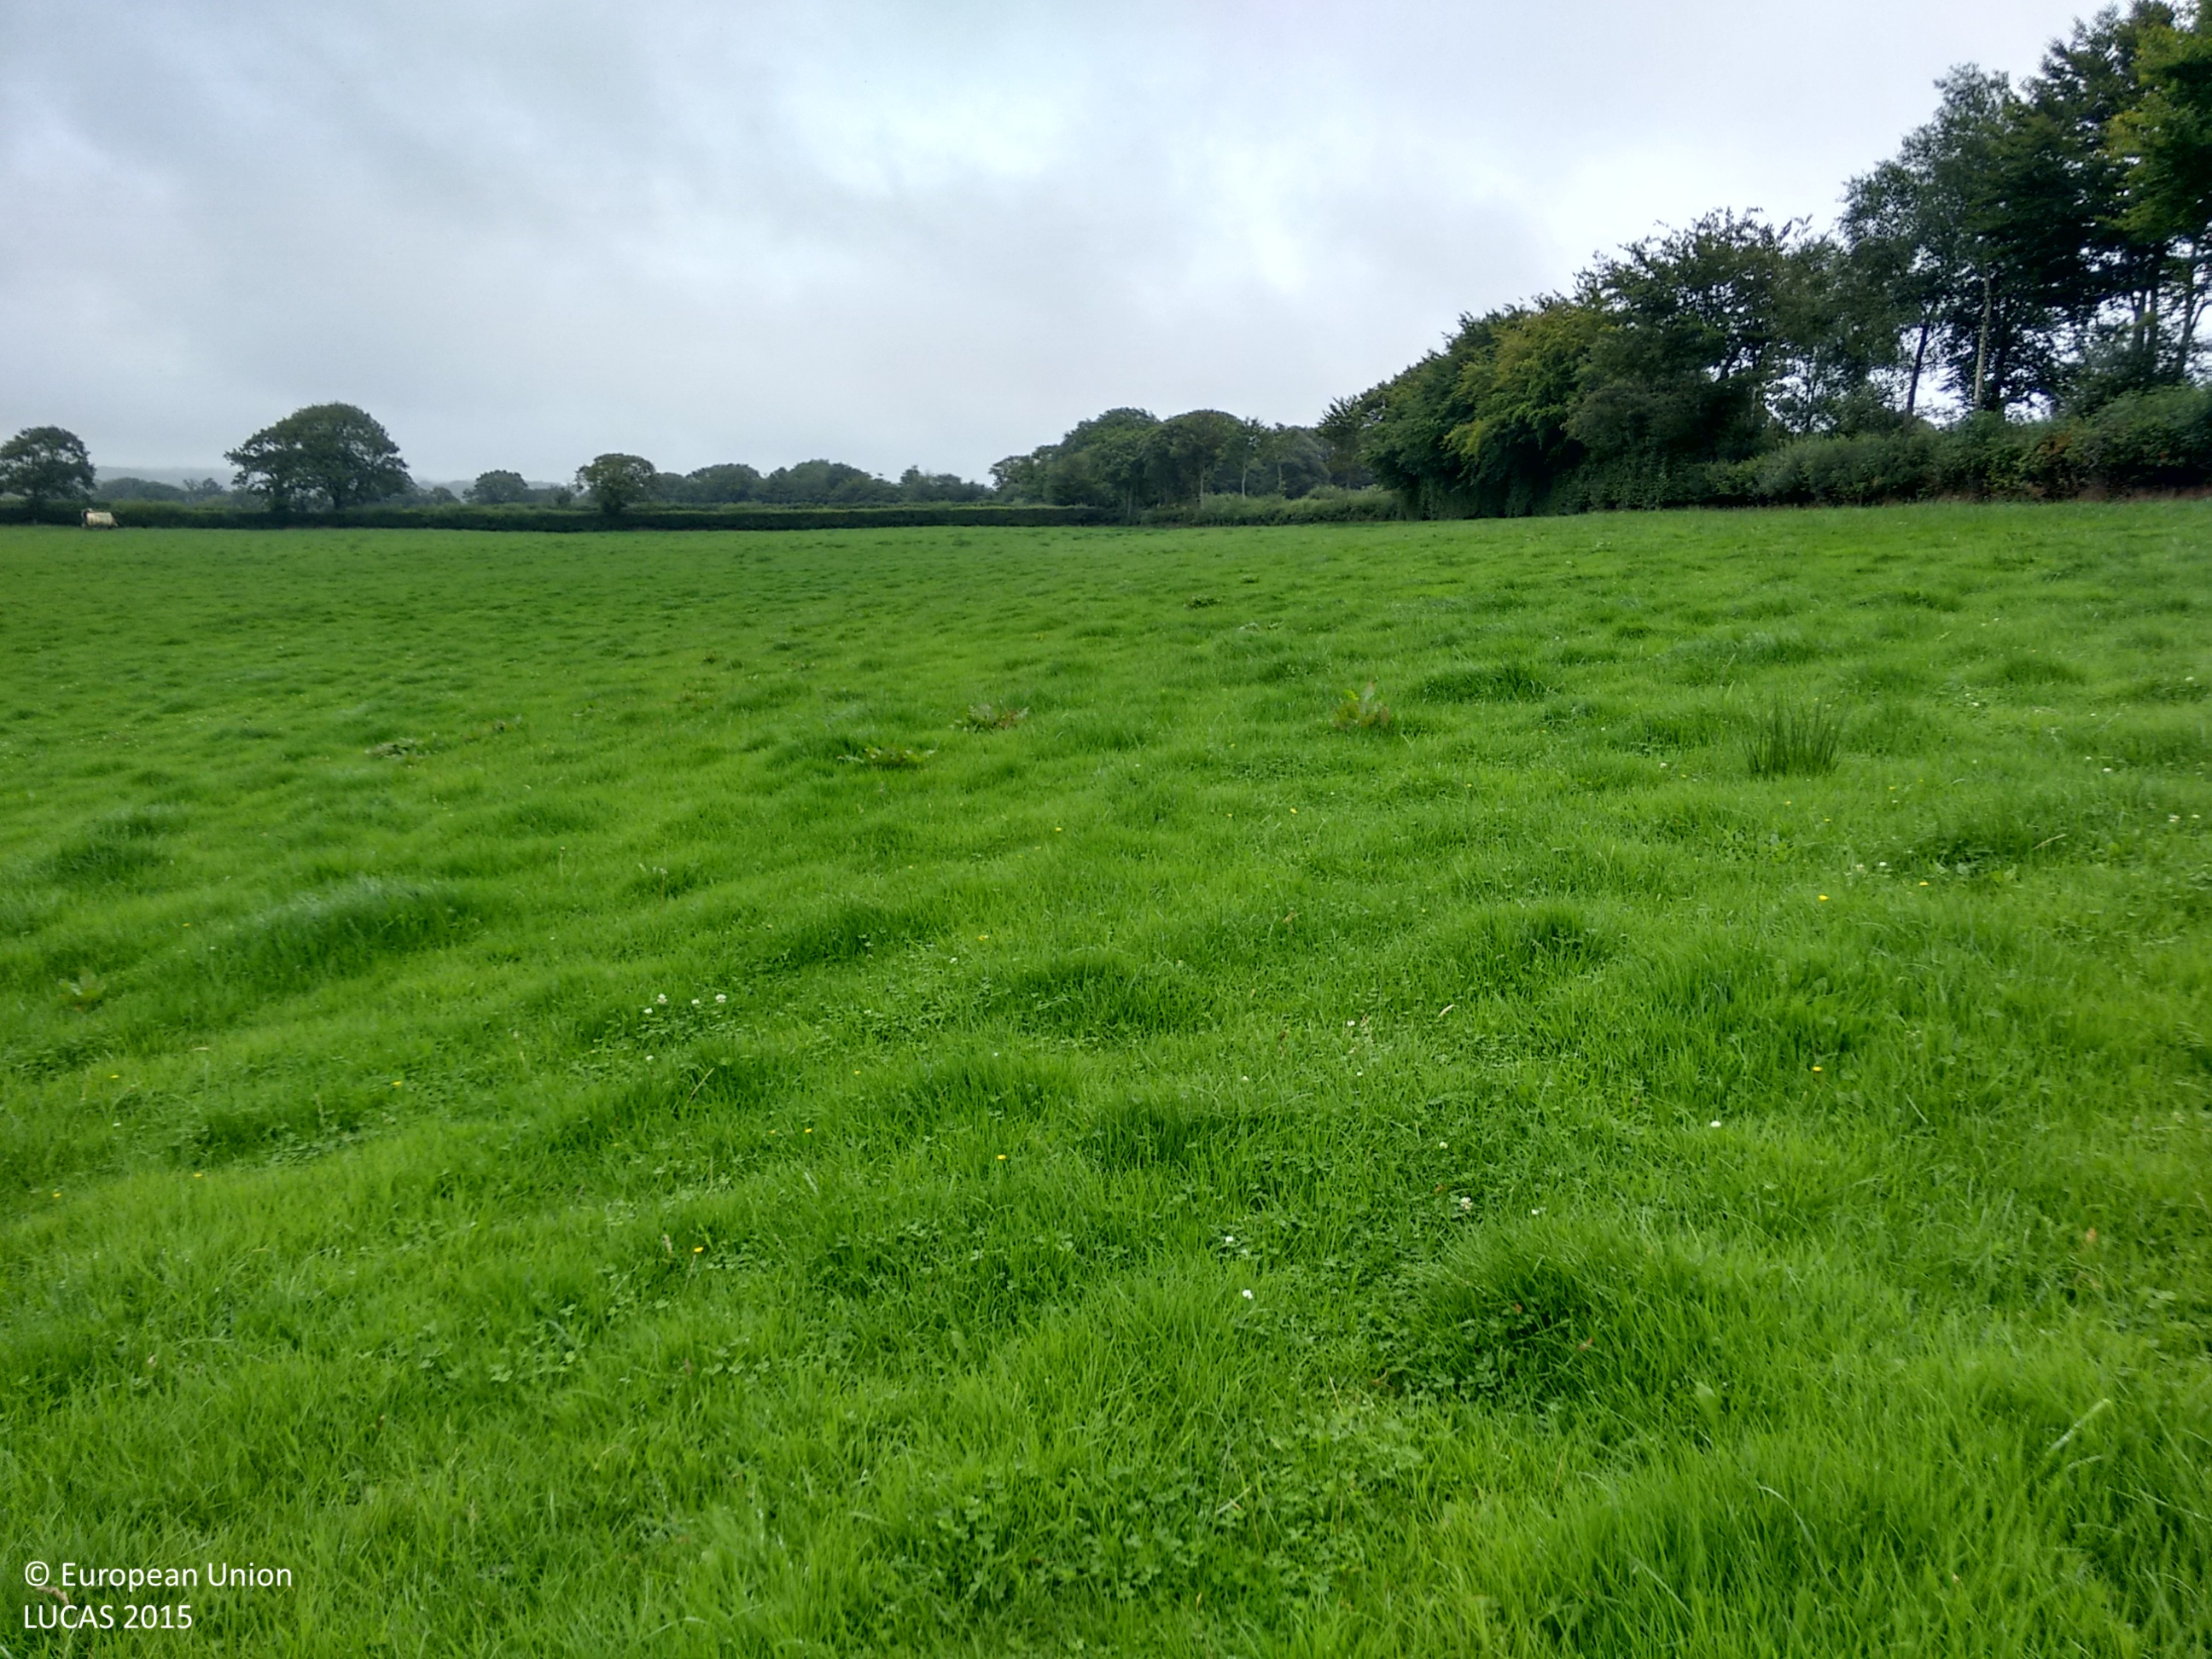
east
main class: Grassland
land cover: Grassland without tree/shrub cover
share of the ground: > 75 %
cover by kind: herbaceous plants 100 %
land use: Agriculture (excluding fallow land and kitchen gardens)
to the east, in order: Grassland without tree/shrub cover; Ditches and canals; Broadleaved woodland; Grass margins; Paved roads, cycling and walking lanes; Ditches and canals; Managed hedges
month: August
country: GB
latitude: 50.9278
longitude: -3.6459
